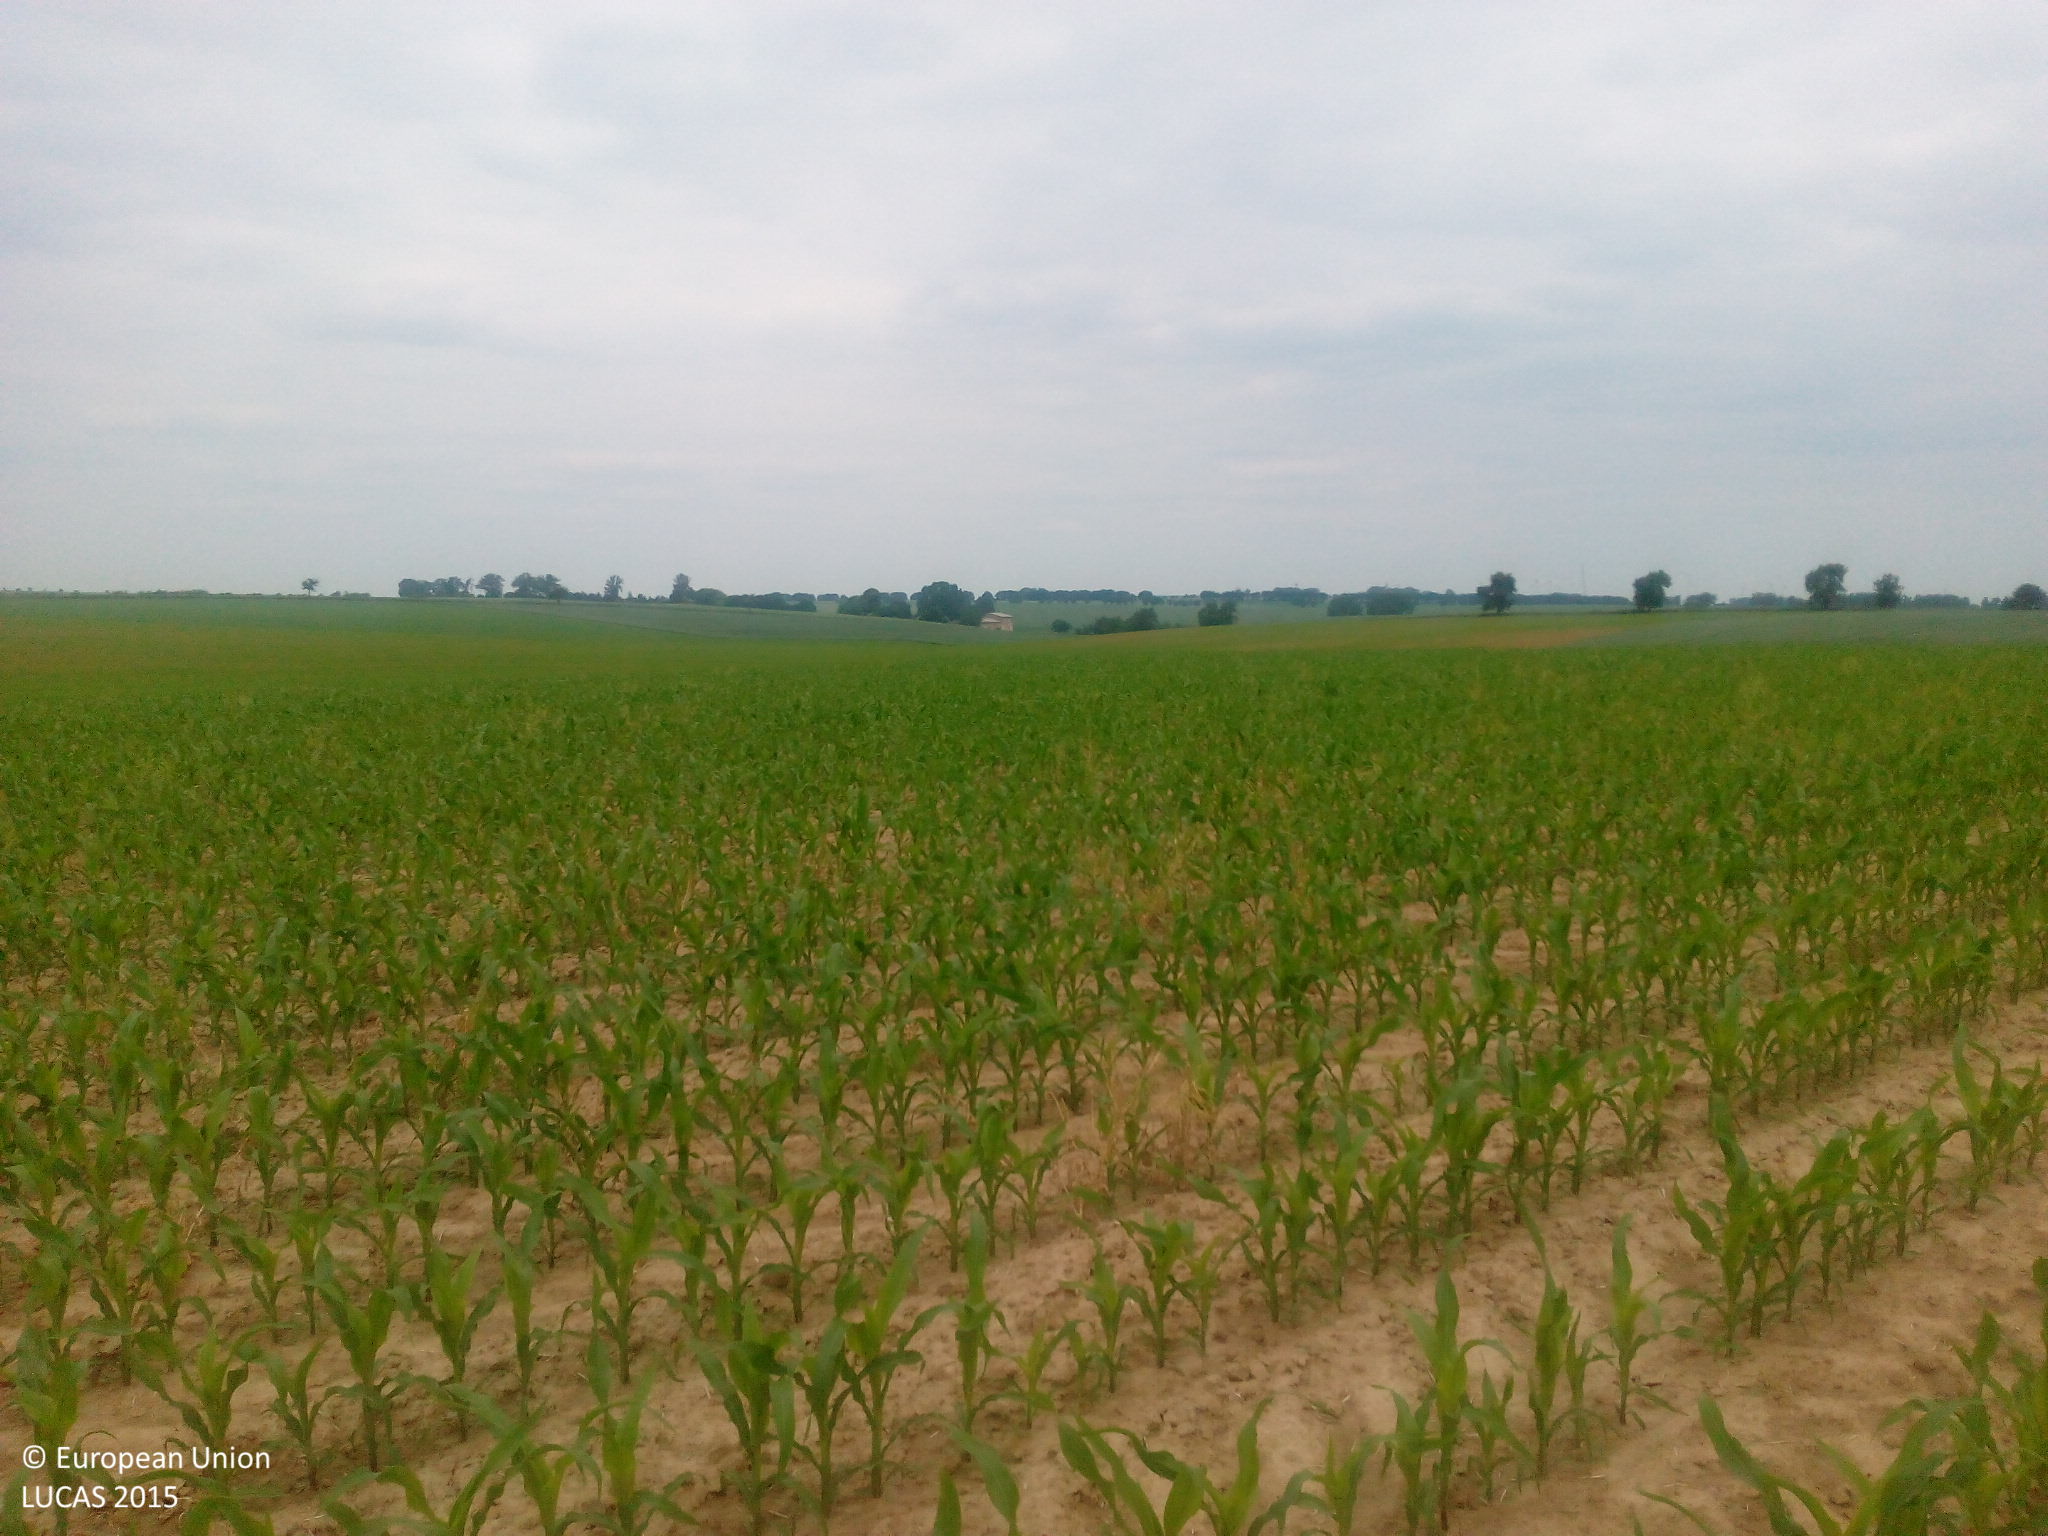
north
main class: Cropland
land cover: Maize
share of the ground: 25 - 50 %
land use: Agriculture (excluding fallow land and kitchen gardens)
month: June
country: DE
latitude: 51.2036
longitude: 13.1059
